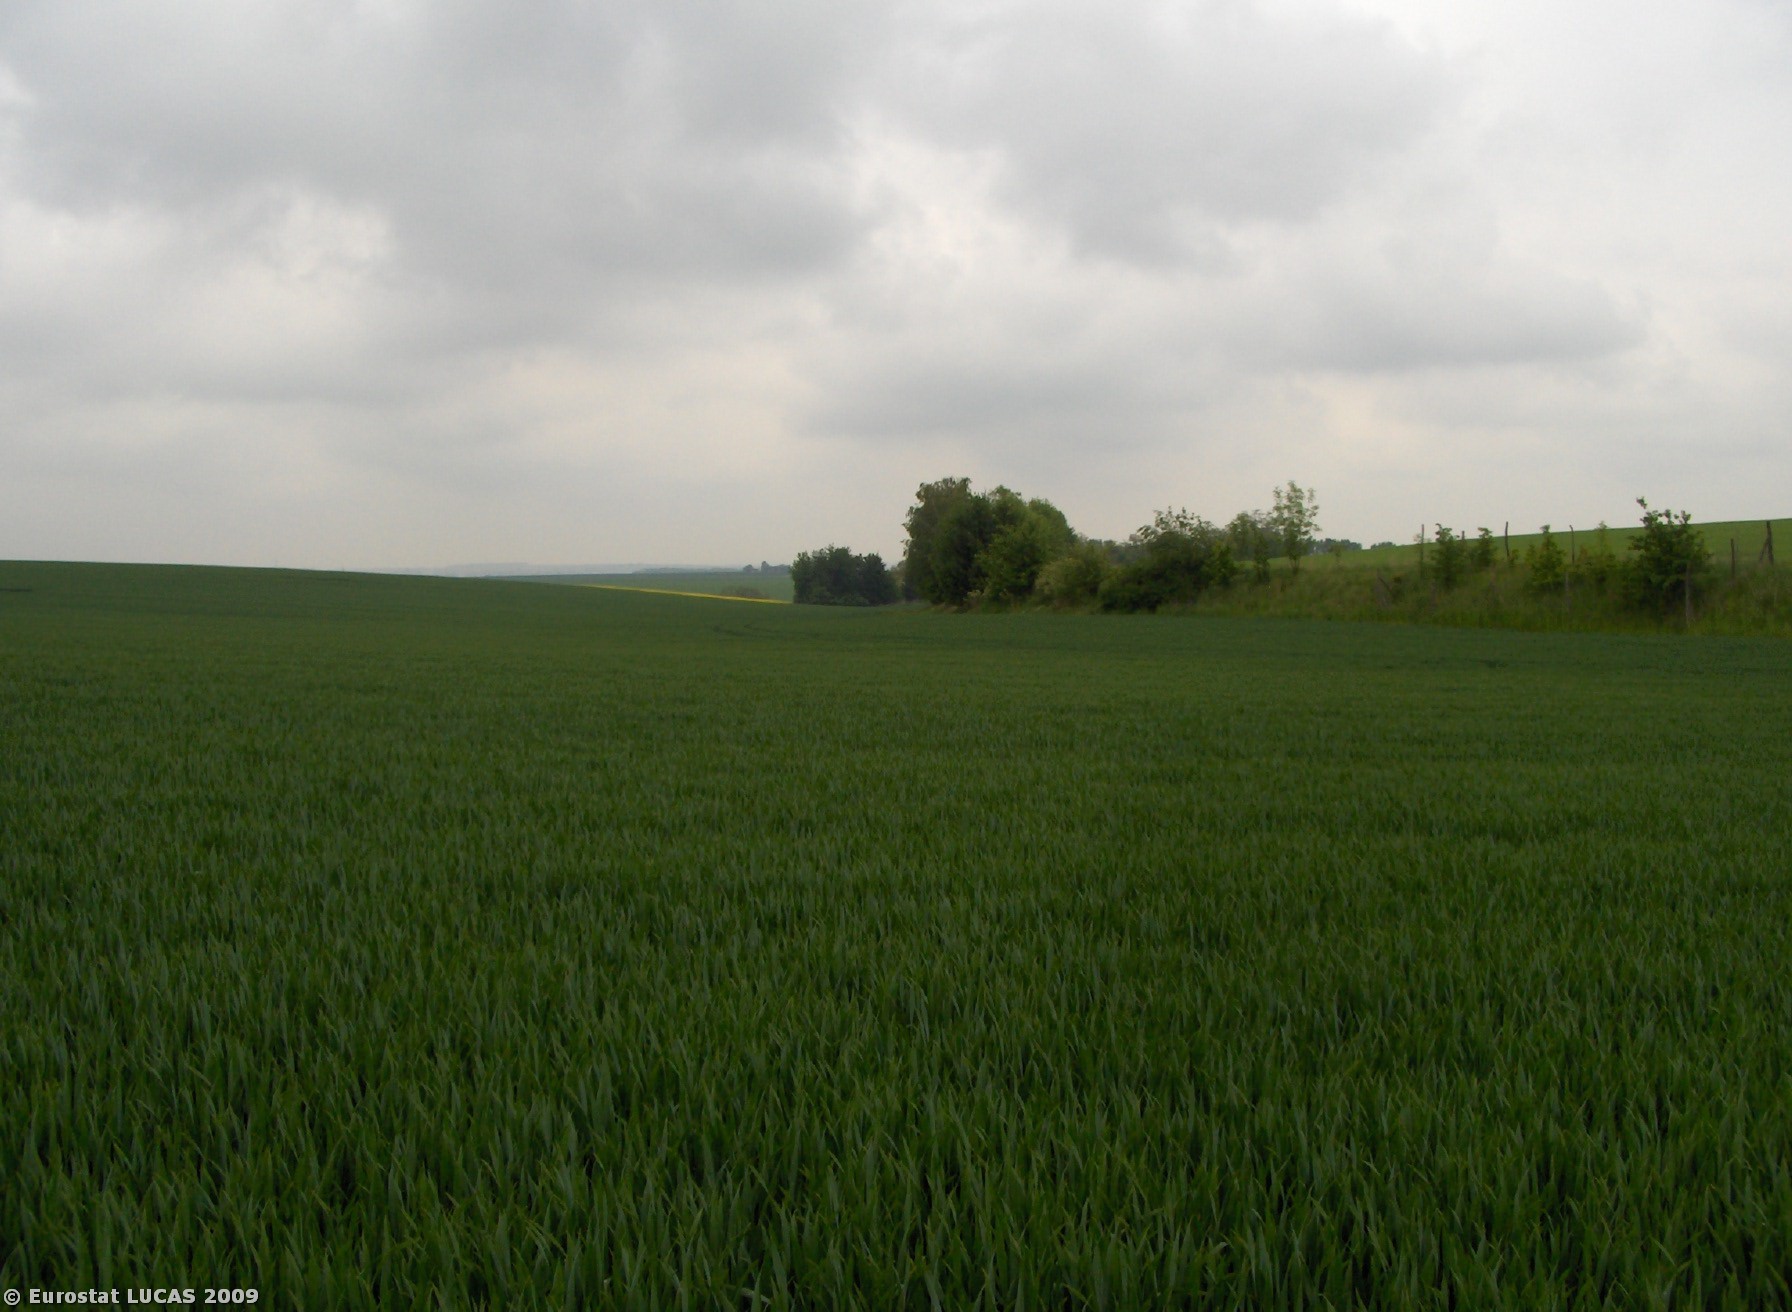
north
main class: Cropland
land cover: Common wheat
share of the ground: > 75 %
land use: Agriculture (excluding fallow land and kitchen gardens)
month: May
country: CZ
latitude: 49.3992
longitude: 17.1617
